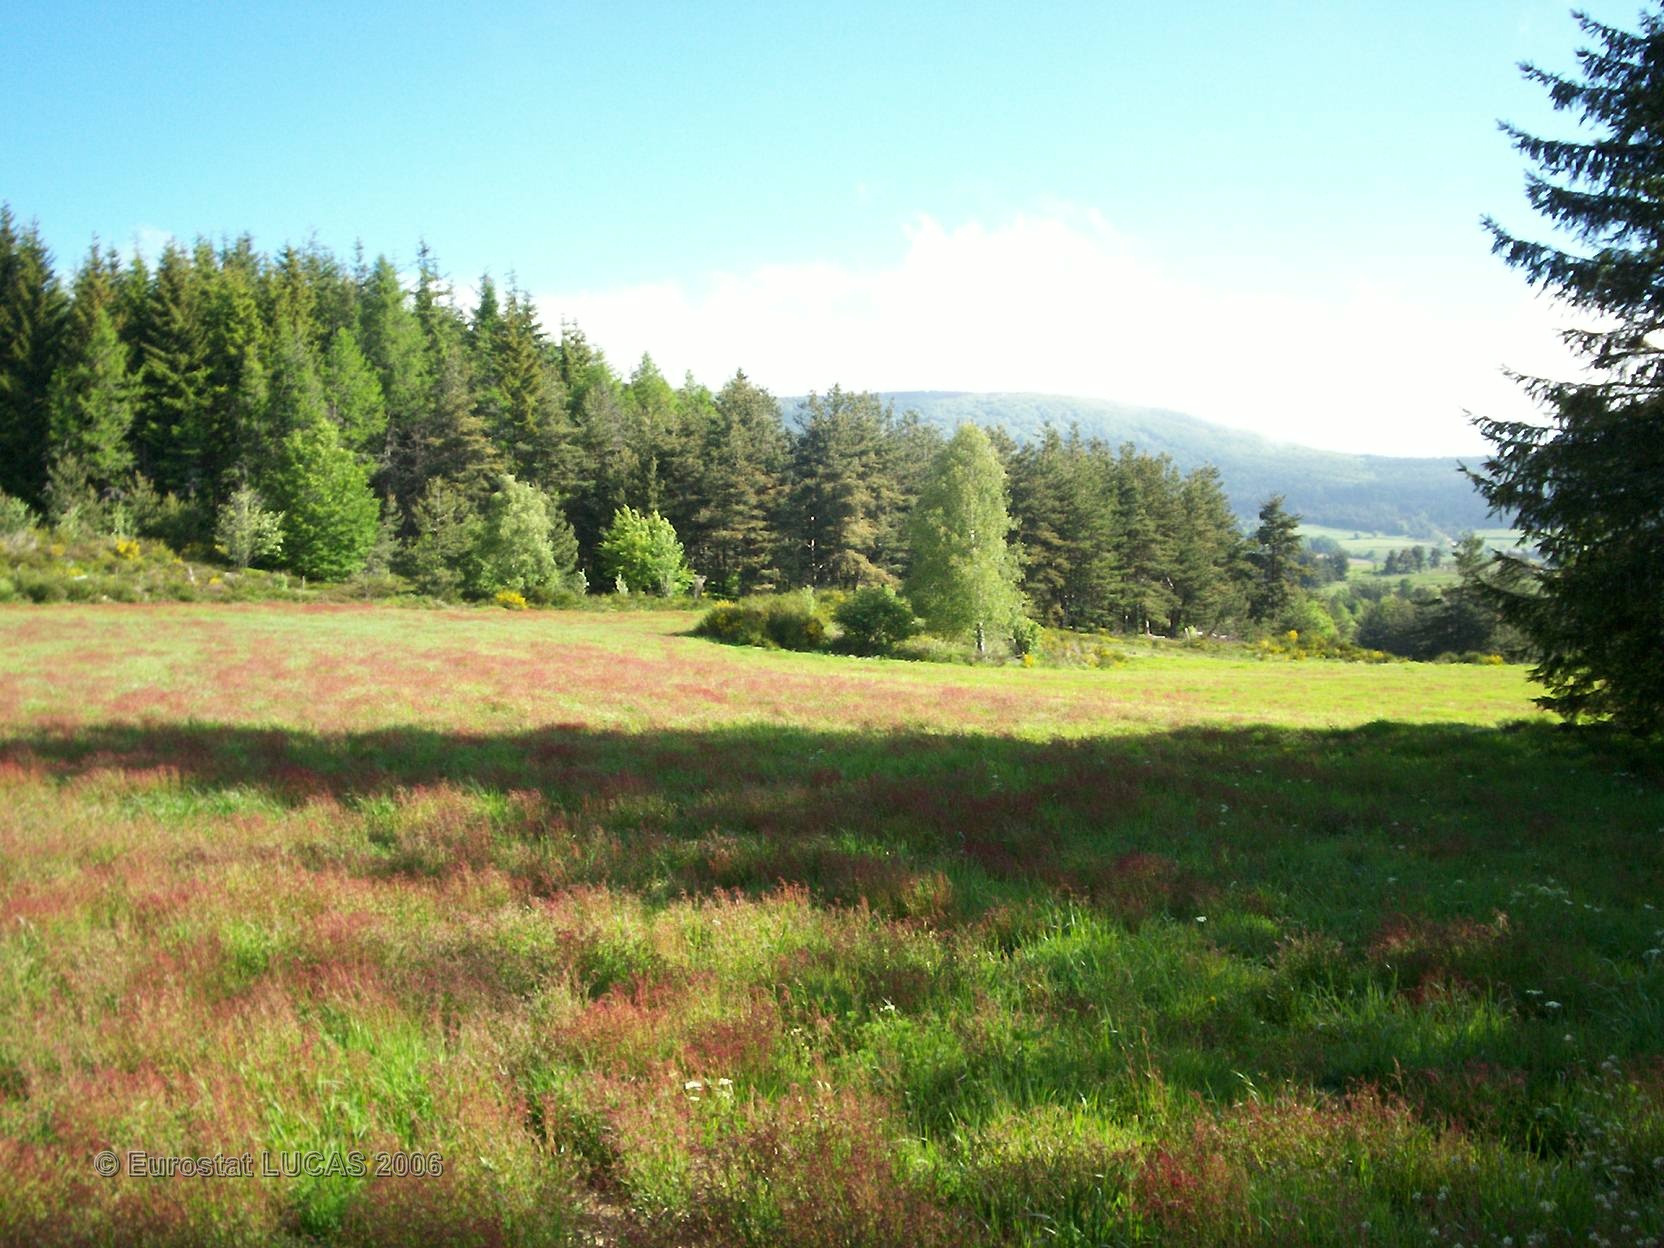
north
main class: Grassland
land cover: Grassland without tree/shrub cover
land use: Agriculture (excluding fallow land and kitchen gardens)
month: June
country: FR
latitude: 44.9526
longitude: 3.3741
